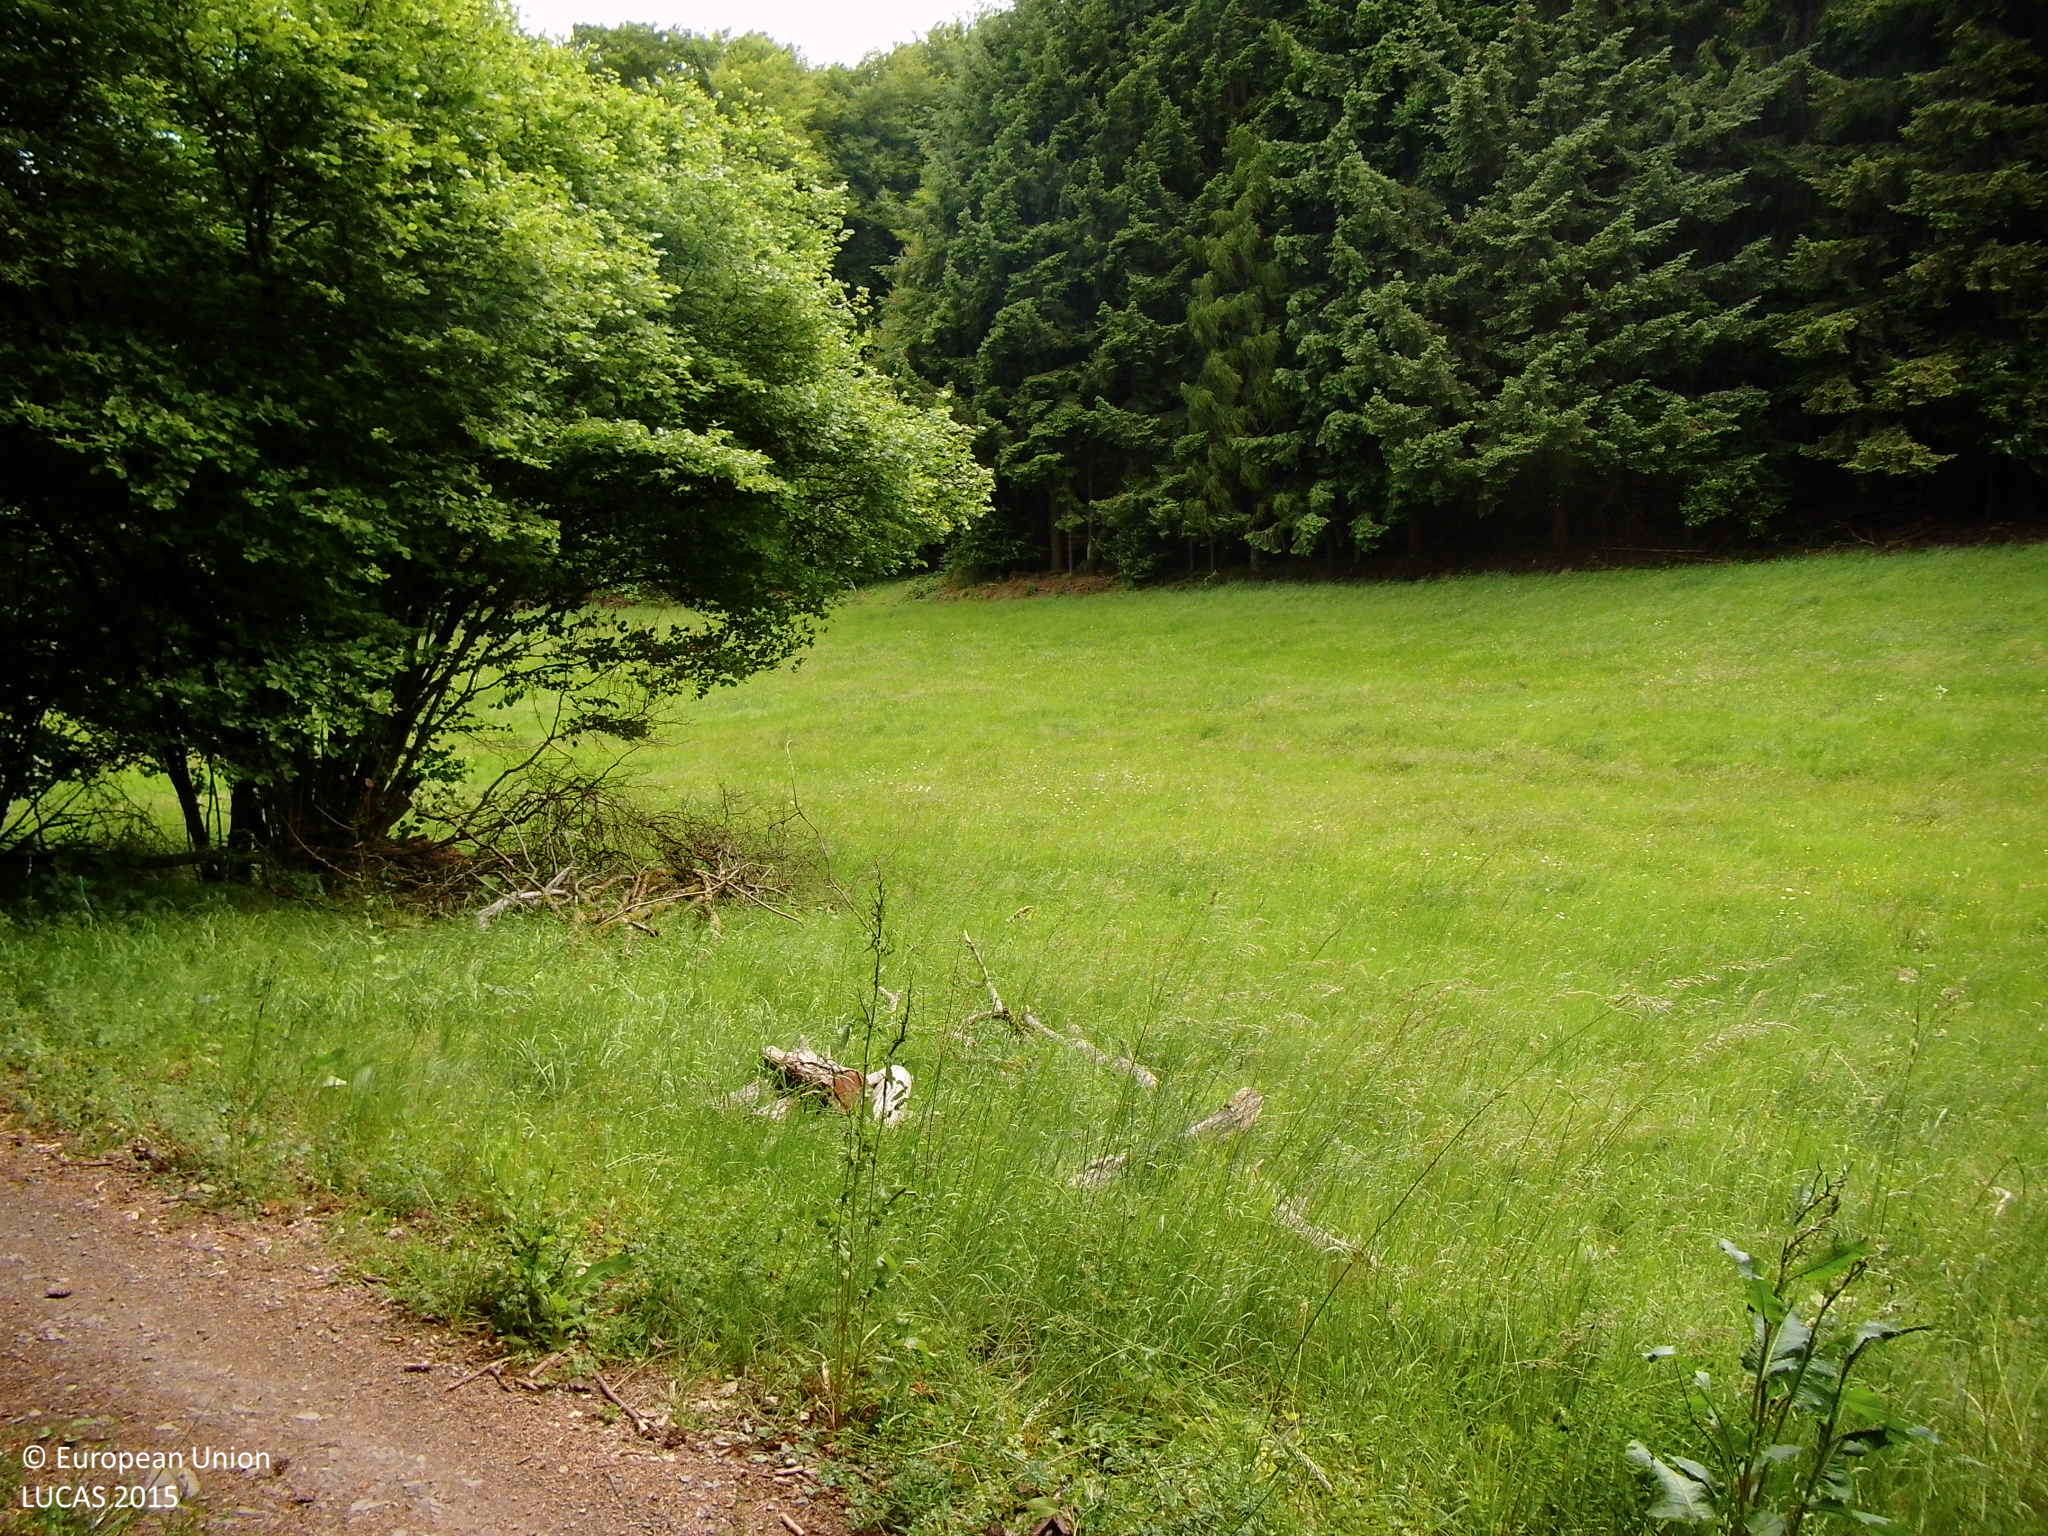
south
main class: Woodland
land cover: Spruce dominated mixed woodland
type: hemiboreal forest and nemoral coniferous forest and mixed broadleaved-coniferous forest
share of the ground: > 75 %
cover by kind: coniferous forest trees 65 %, broadleaved forest trees 30 %, unconsolidated bare surface 5 %
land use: Forestry
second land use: Amenities, museums, leisure
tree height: > 5 m
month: June
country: DE
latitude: 50.7313
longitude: 8.4561
